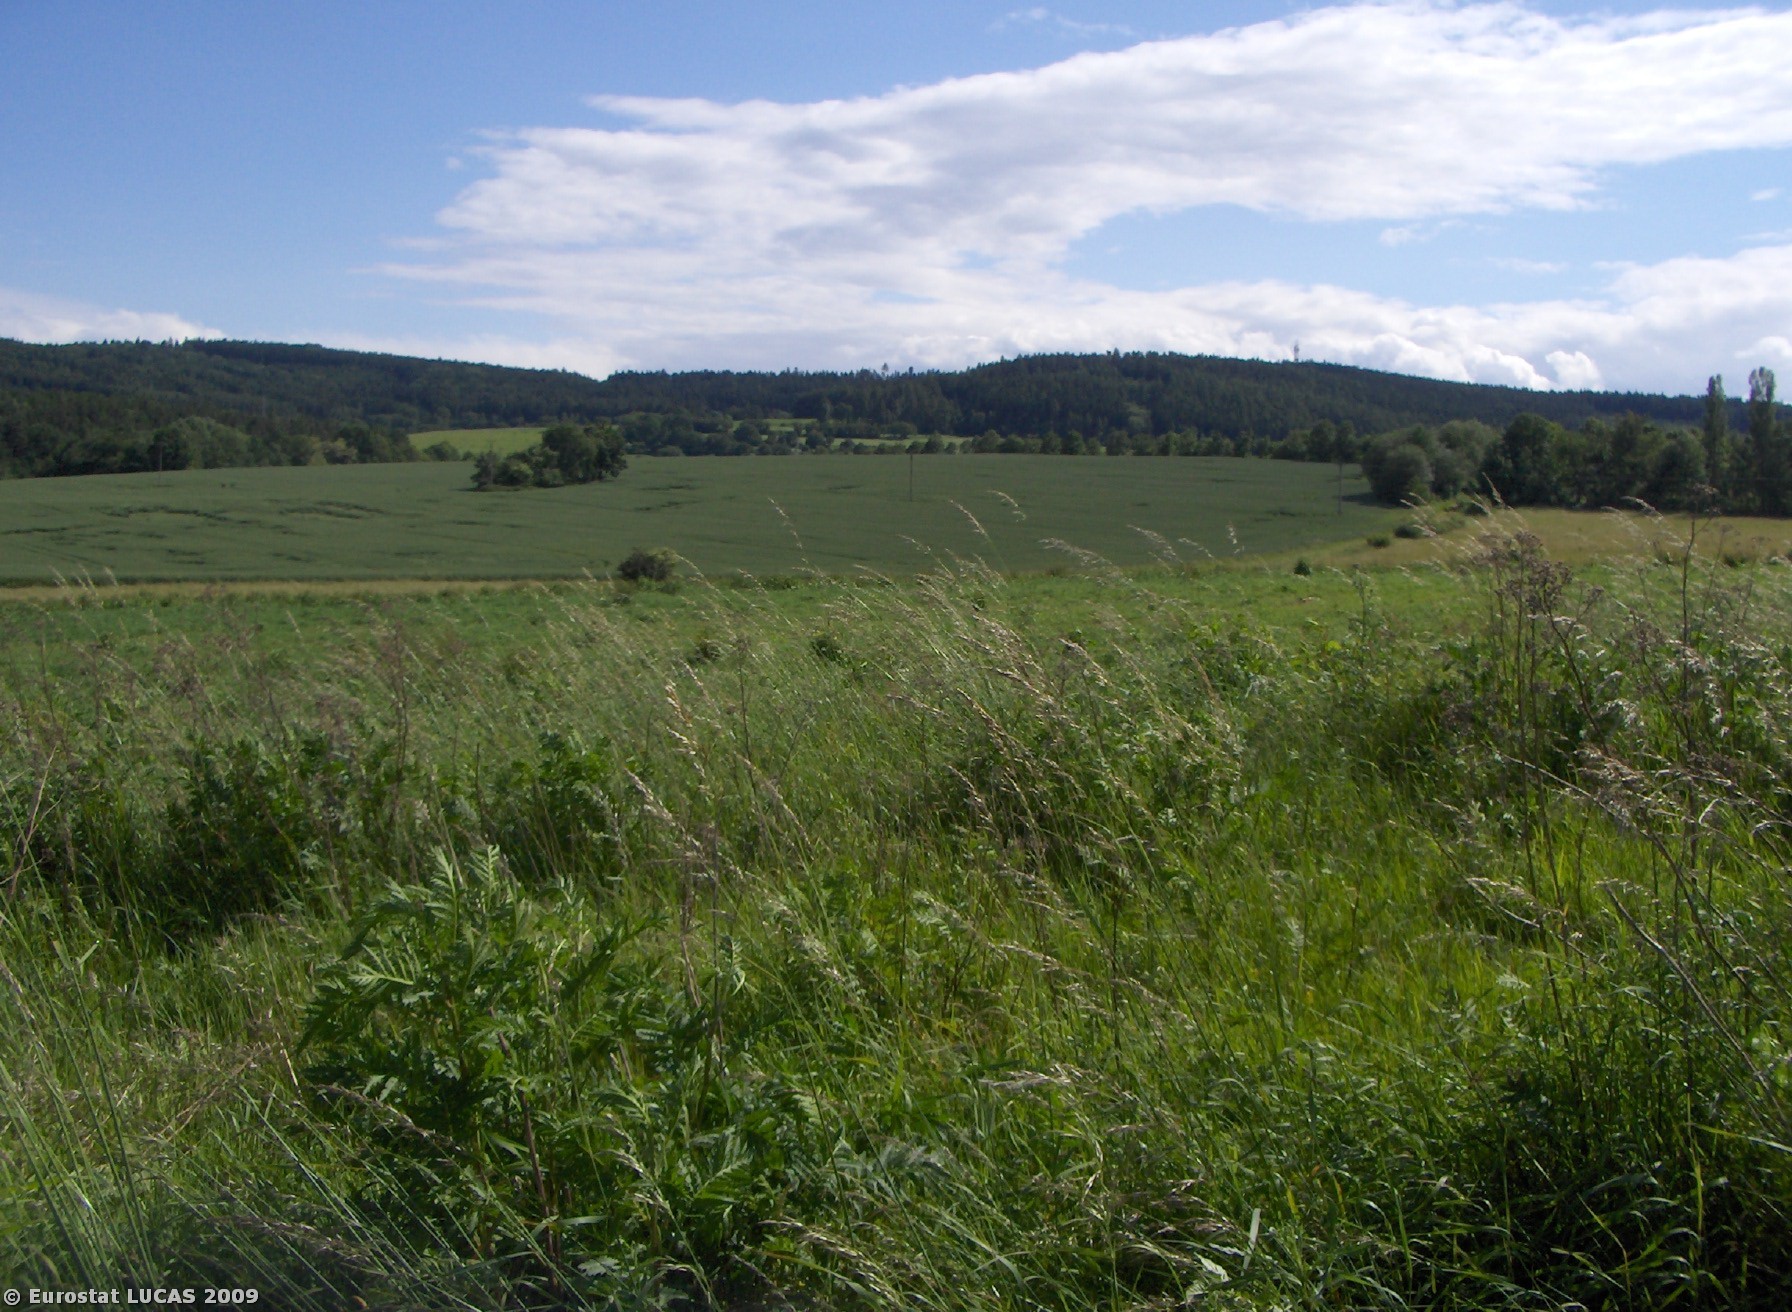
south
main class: Cropland
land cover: Common wheat
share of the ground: > 75 %
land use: Agriculture (excluding fallow land and kitchen gardens)
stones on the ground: < 10 %
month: June
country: CZ
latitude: 49.2120
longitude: 14.0502
